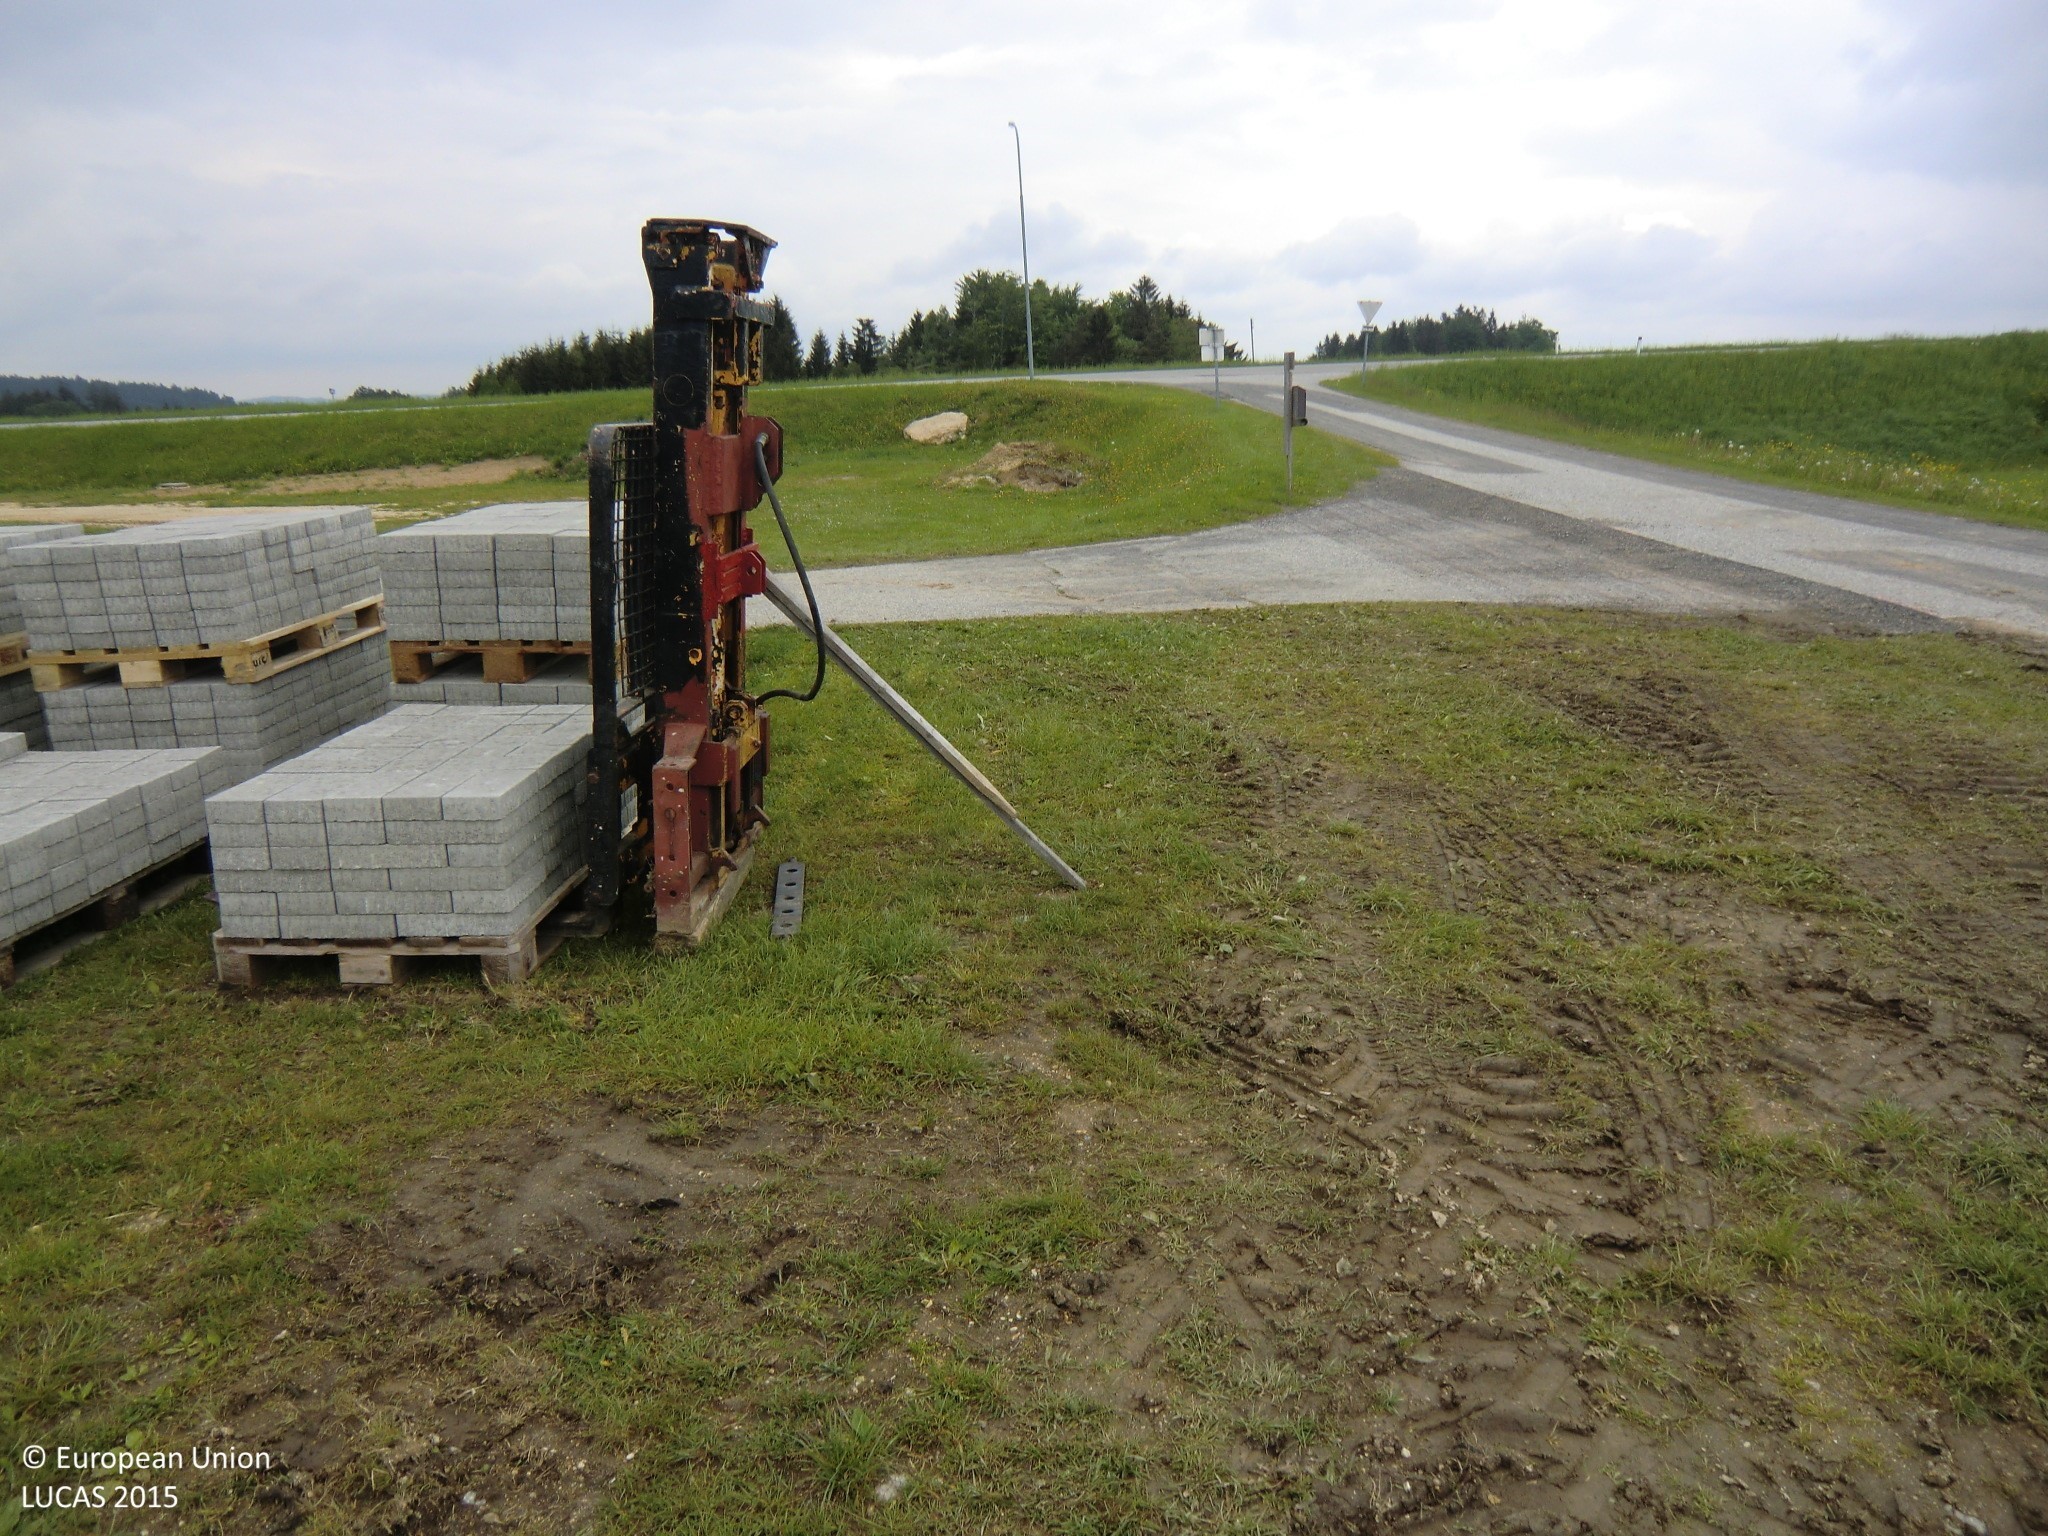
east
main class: Grassland
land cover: Spontaneously vegetated surfaces
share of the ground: 25 - 50 %
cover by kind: herbaceous plants 50 %, unconsolidated bare surface 50 %
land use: Residential
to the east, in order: Spontaneously vegetated surfaces; Paved roads, cycling and walking lanes; Grassland without tree/shrub cover; Paved roads, cycling and walking lanes; Grassland without tree/shrub cover; Dry pulses; Grassland without tree/shrub cover; Tracks; Broadleaved woodland; Grassland without tree/shrub cover; Tracks; Spruce dominated coniferous woodland
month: May
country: AT
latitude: 48.4363
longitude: 14.9621
